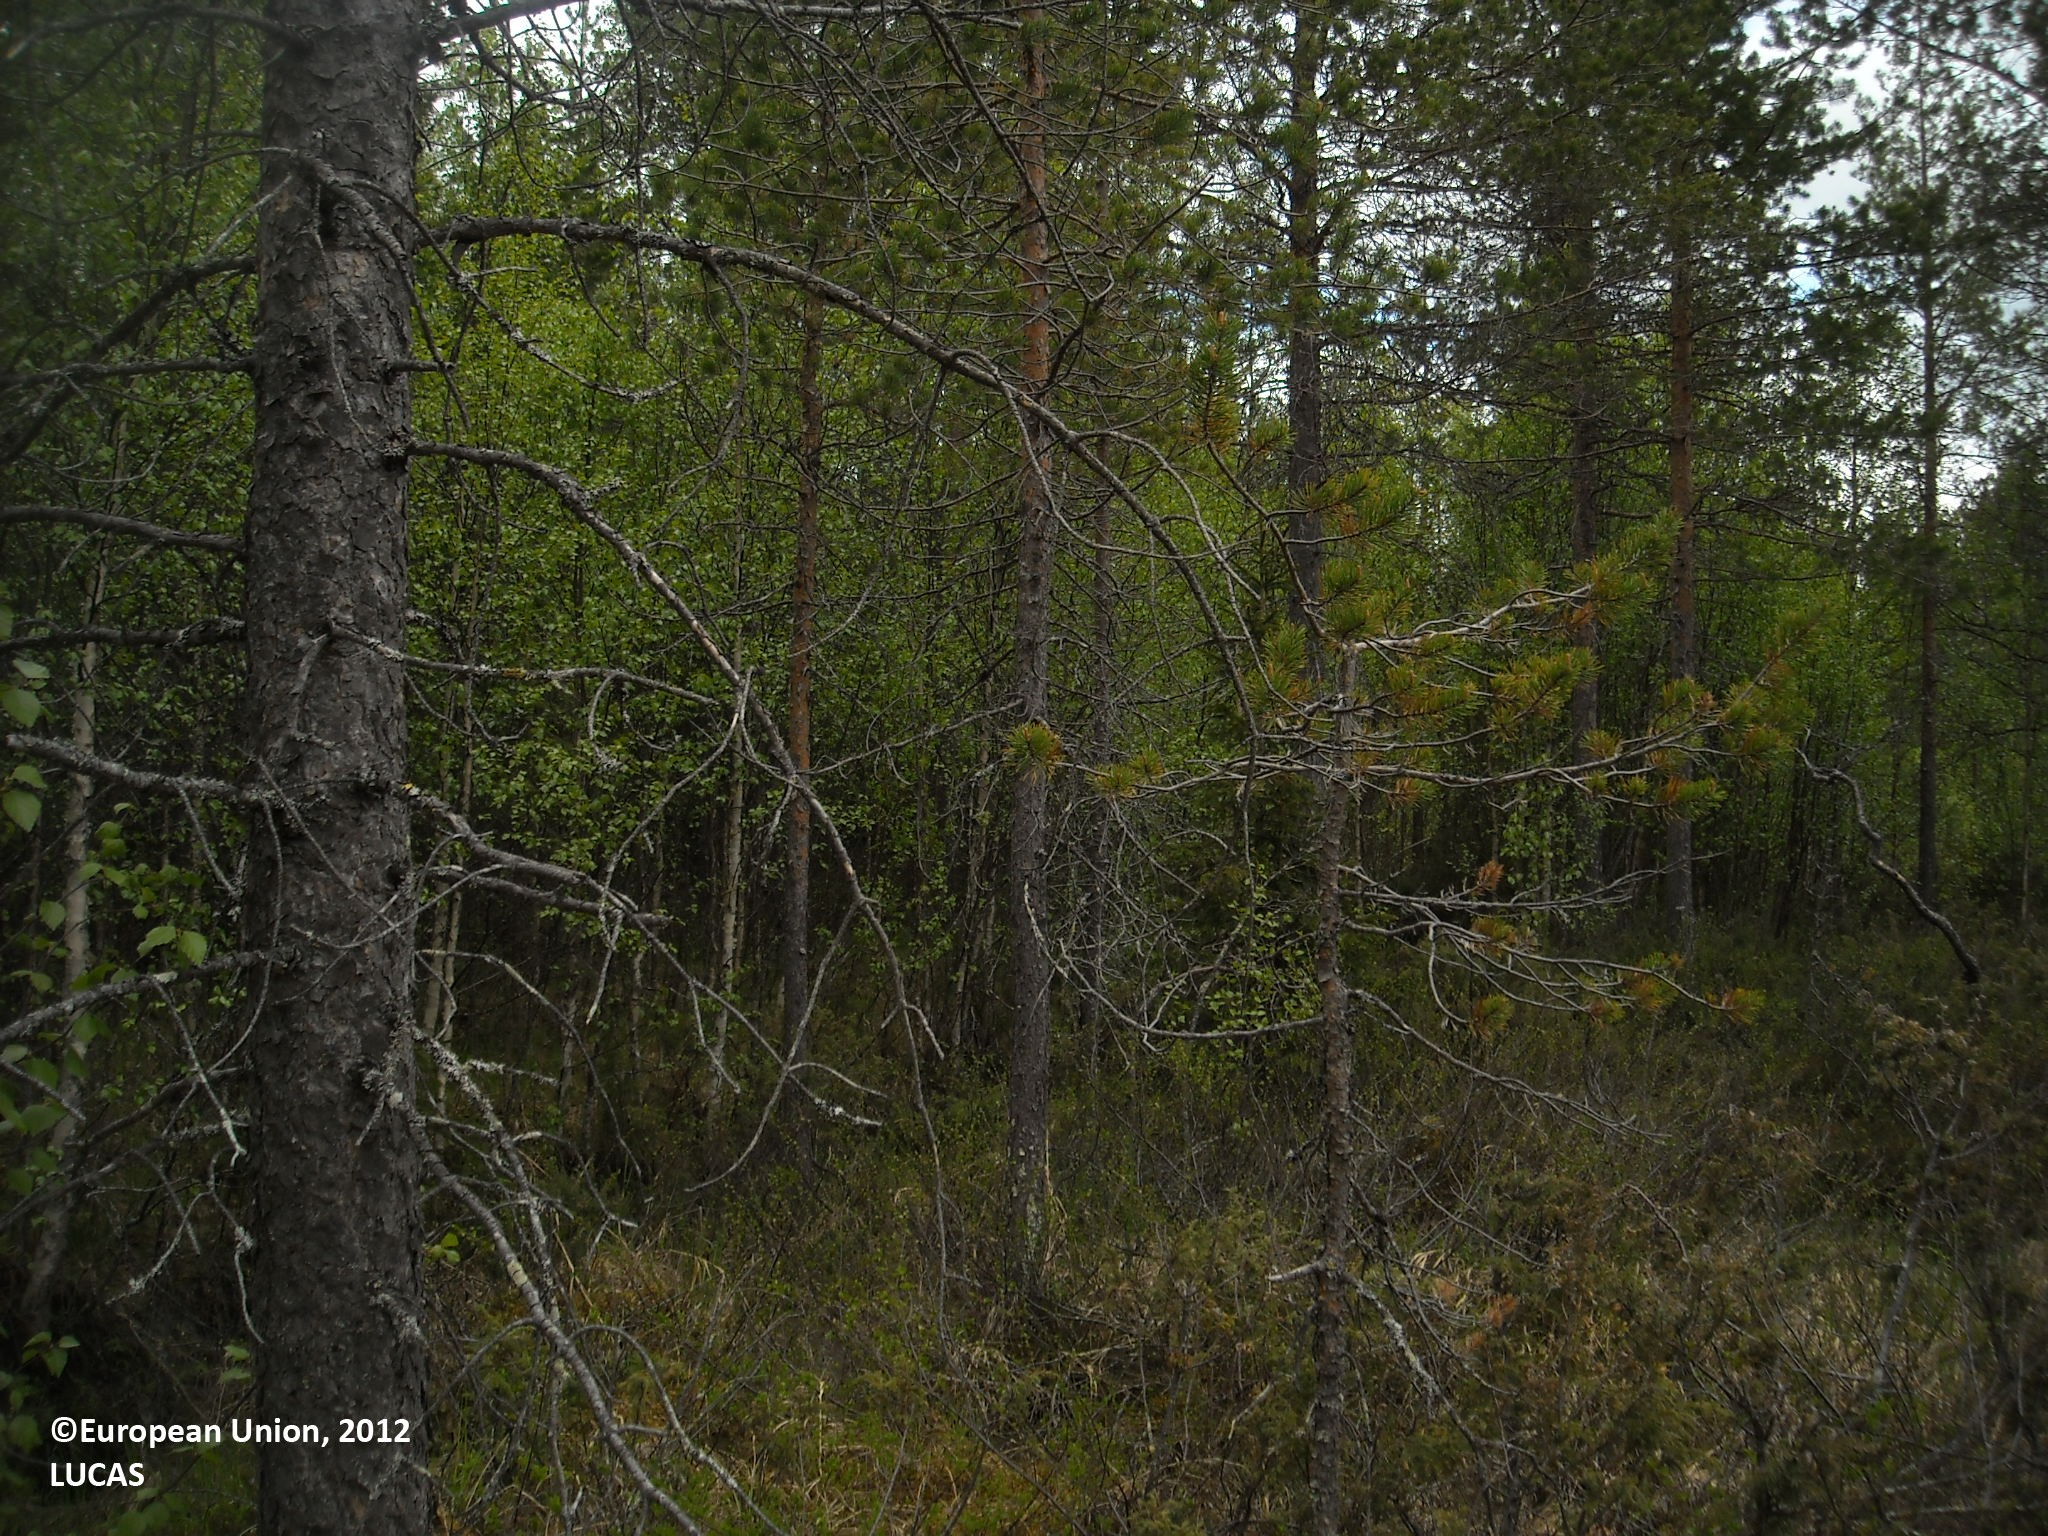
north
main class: Woodland
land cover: Pine dominated mixed woodland
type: mire and swamp forests
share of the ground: > 75 %
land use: Forestry
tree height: > 5 m
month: June
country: FI
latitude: 65.3294
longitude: 27.8566
